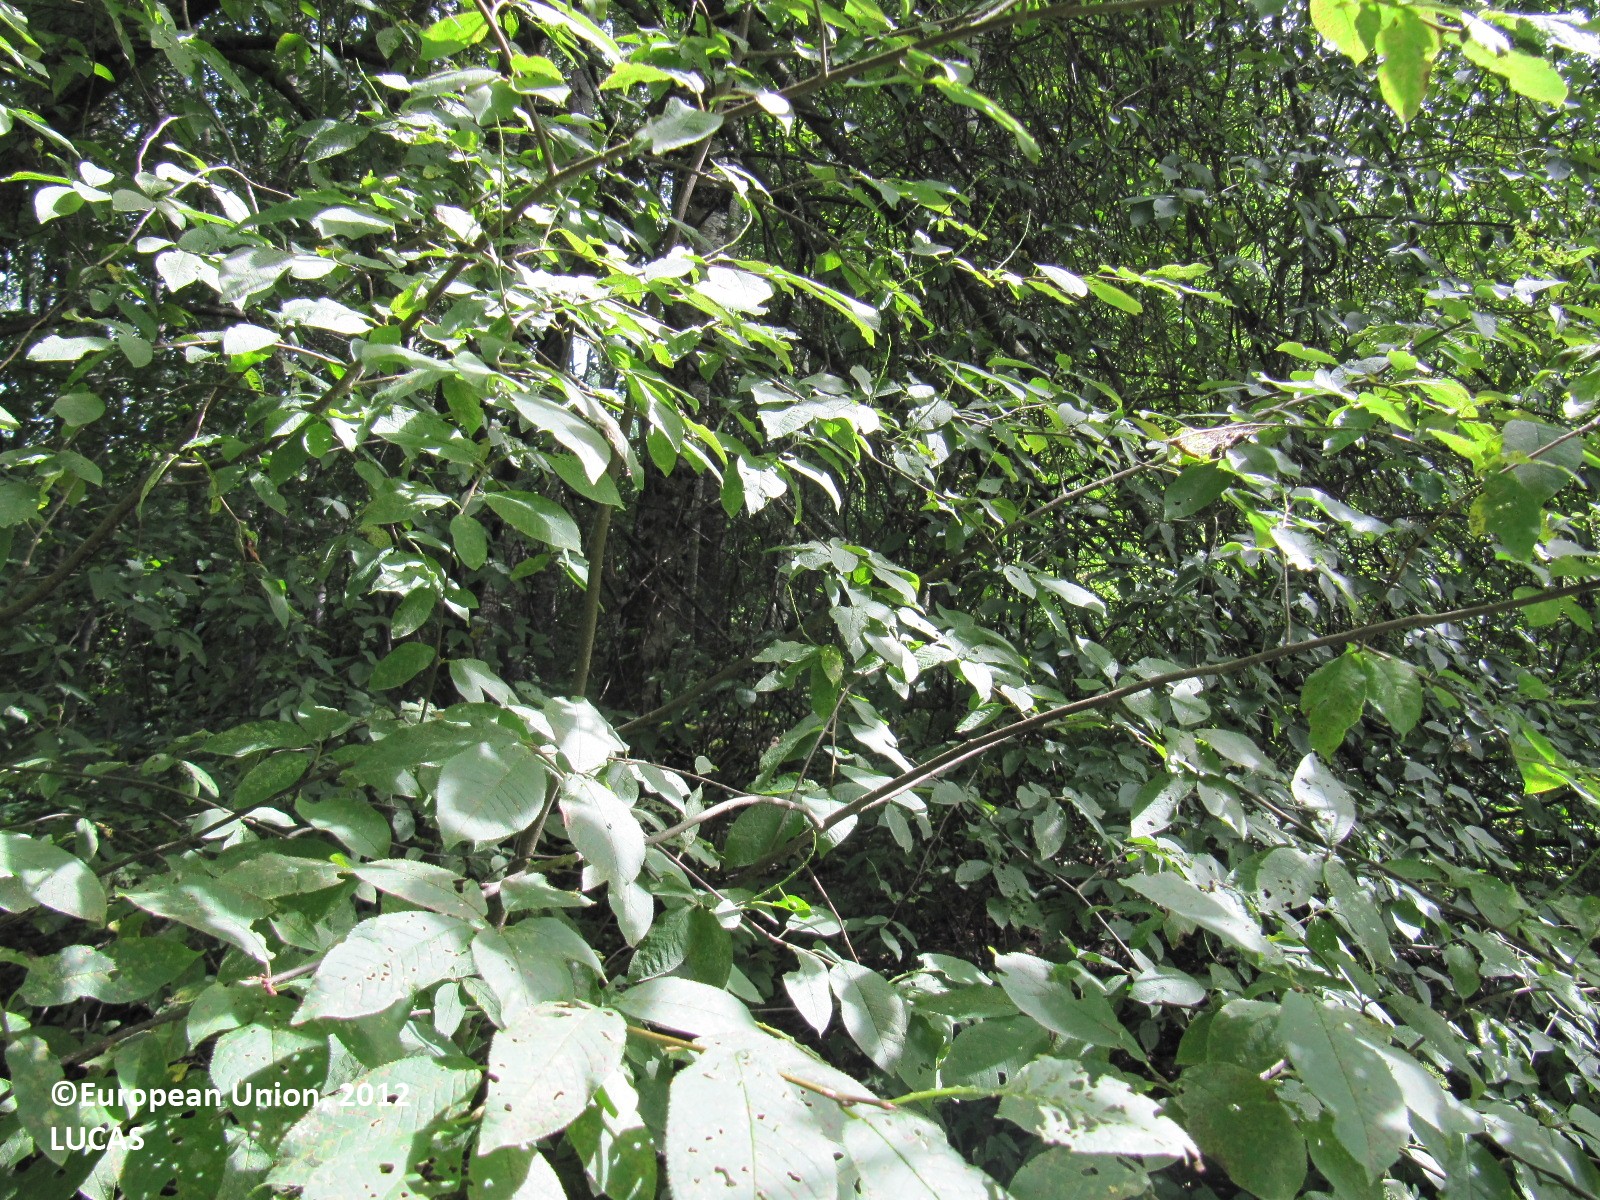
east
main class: Woodland
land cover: Broadleaved woodland
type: boreal forest
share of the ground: > 75 %
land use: Forestry
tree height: > 5 m
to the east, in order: Broadleaved woodland; Electric lines; Broadleaved woodland; Tracks; Grass margins; Tracks; Broadleaved woodland; Grass margins; Common wheat; Ditches and canals; Common wheat
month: July
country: FI
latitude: 61.1718
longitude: 24.6616
